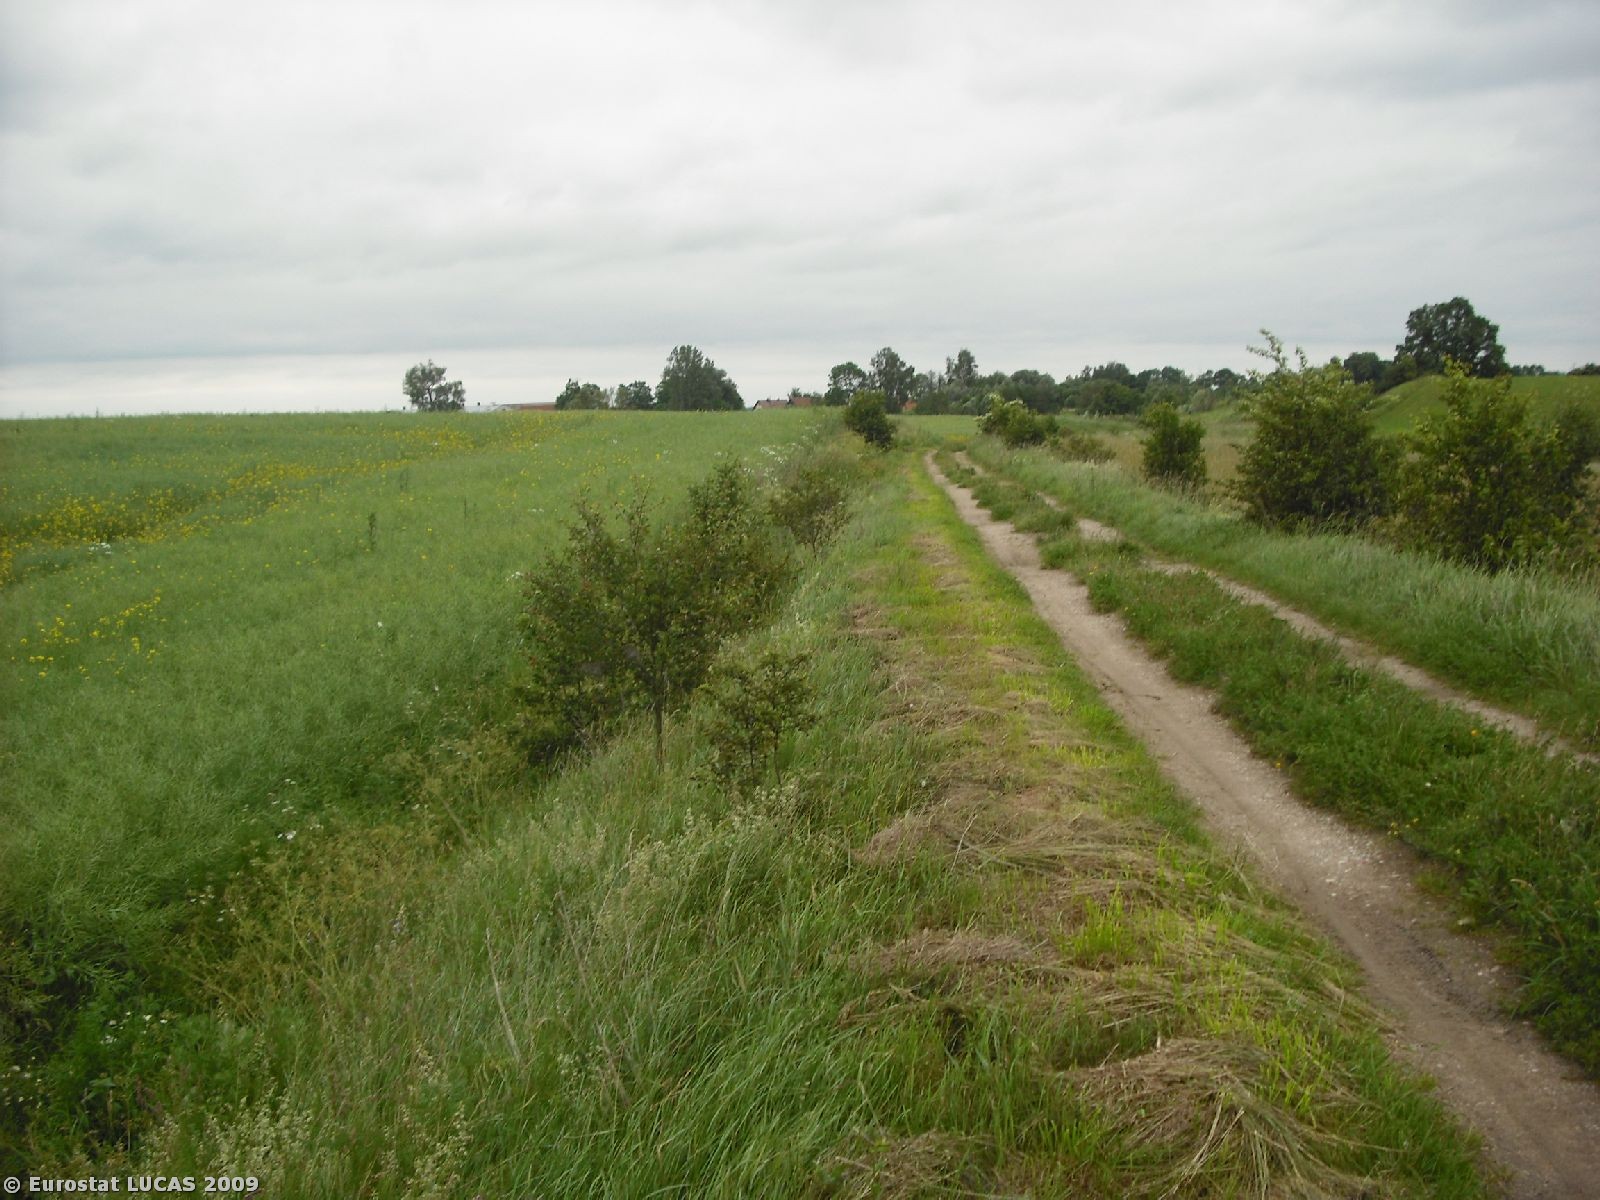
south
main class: Cropland
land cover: Oats
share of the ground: > 75 %
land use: Agriculture (excluding fallow land and kitchen gardens)
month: June
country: PL
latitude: 54.0072
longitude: 22.5002
